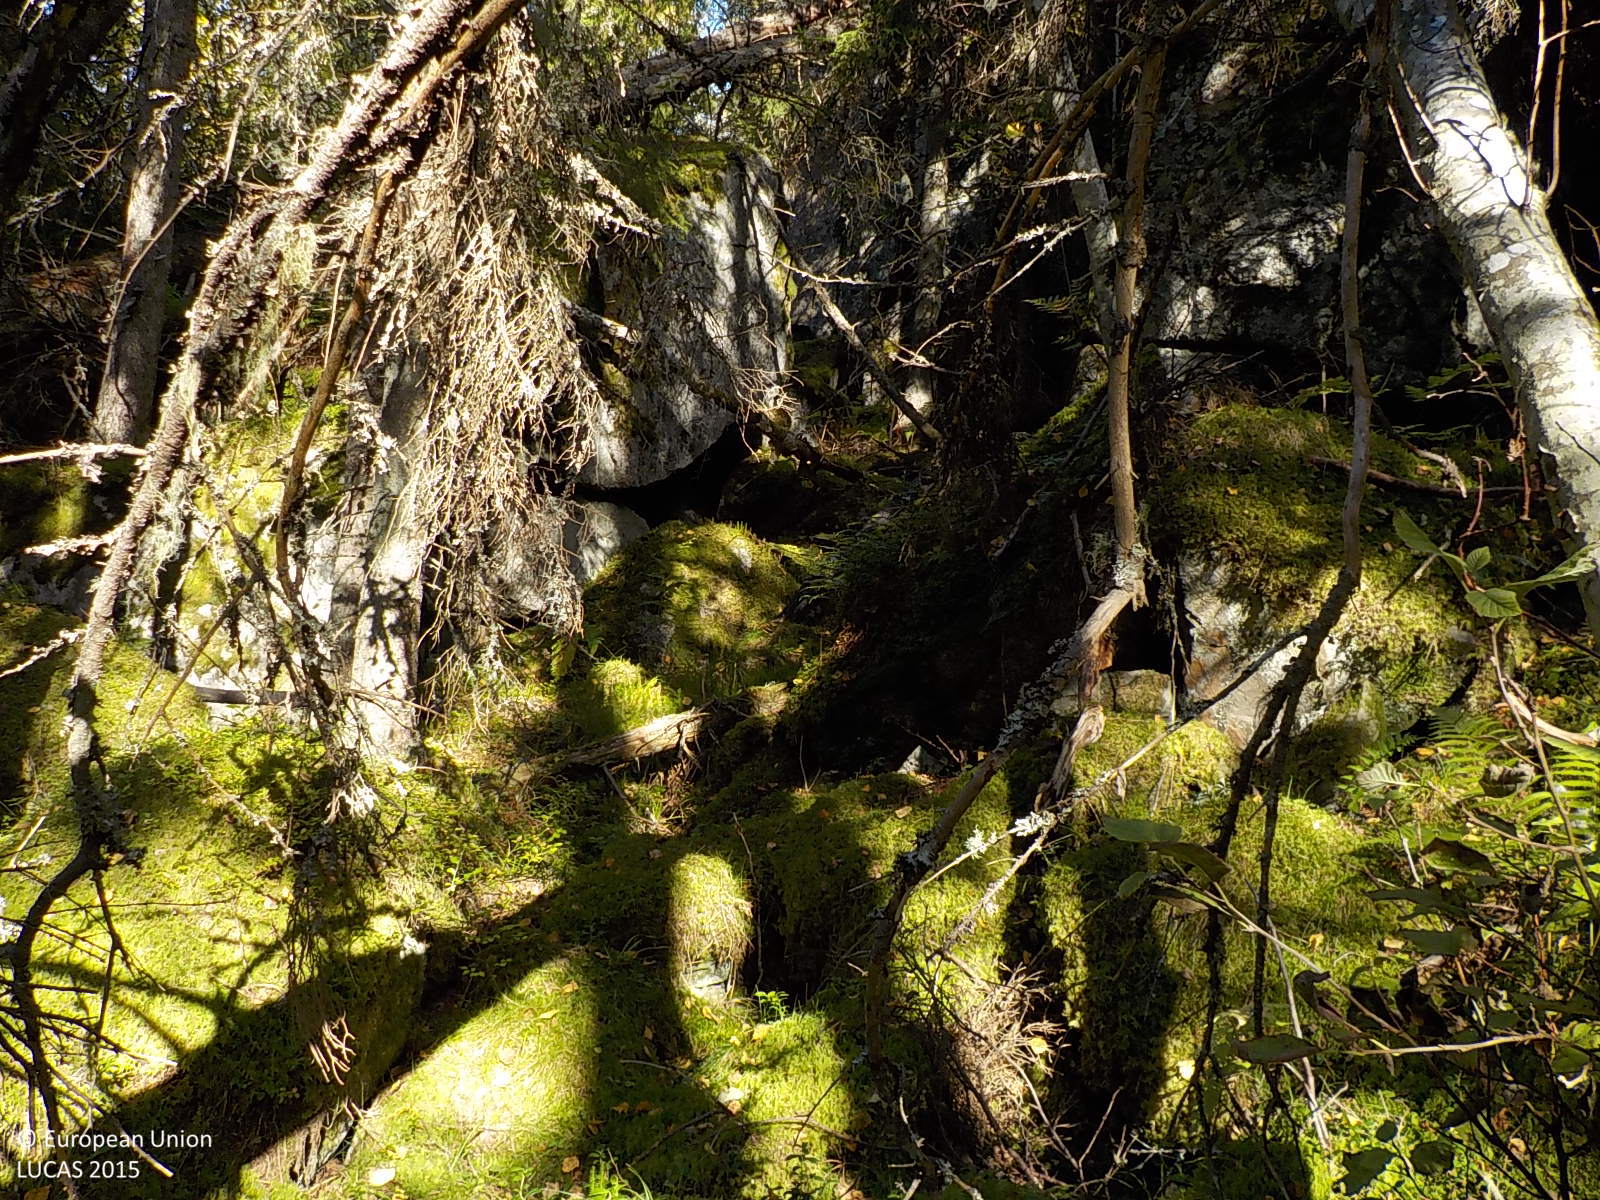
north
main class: Woodland
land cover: Spruce dominated coniferous woodland
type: boreal forest
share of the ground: > 75 %
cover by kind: coniferous forest trees 75 %, lichens and mosses 10 %, consolidated bare surface 10 %, shrubs 5 %
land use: Forestry
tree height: > 5 m
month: September
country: SE
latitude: 62.9184
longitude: 18.4659
